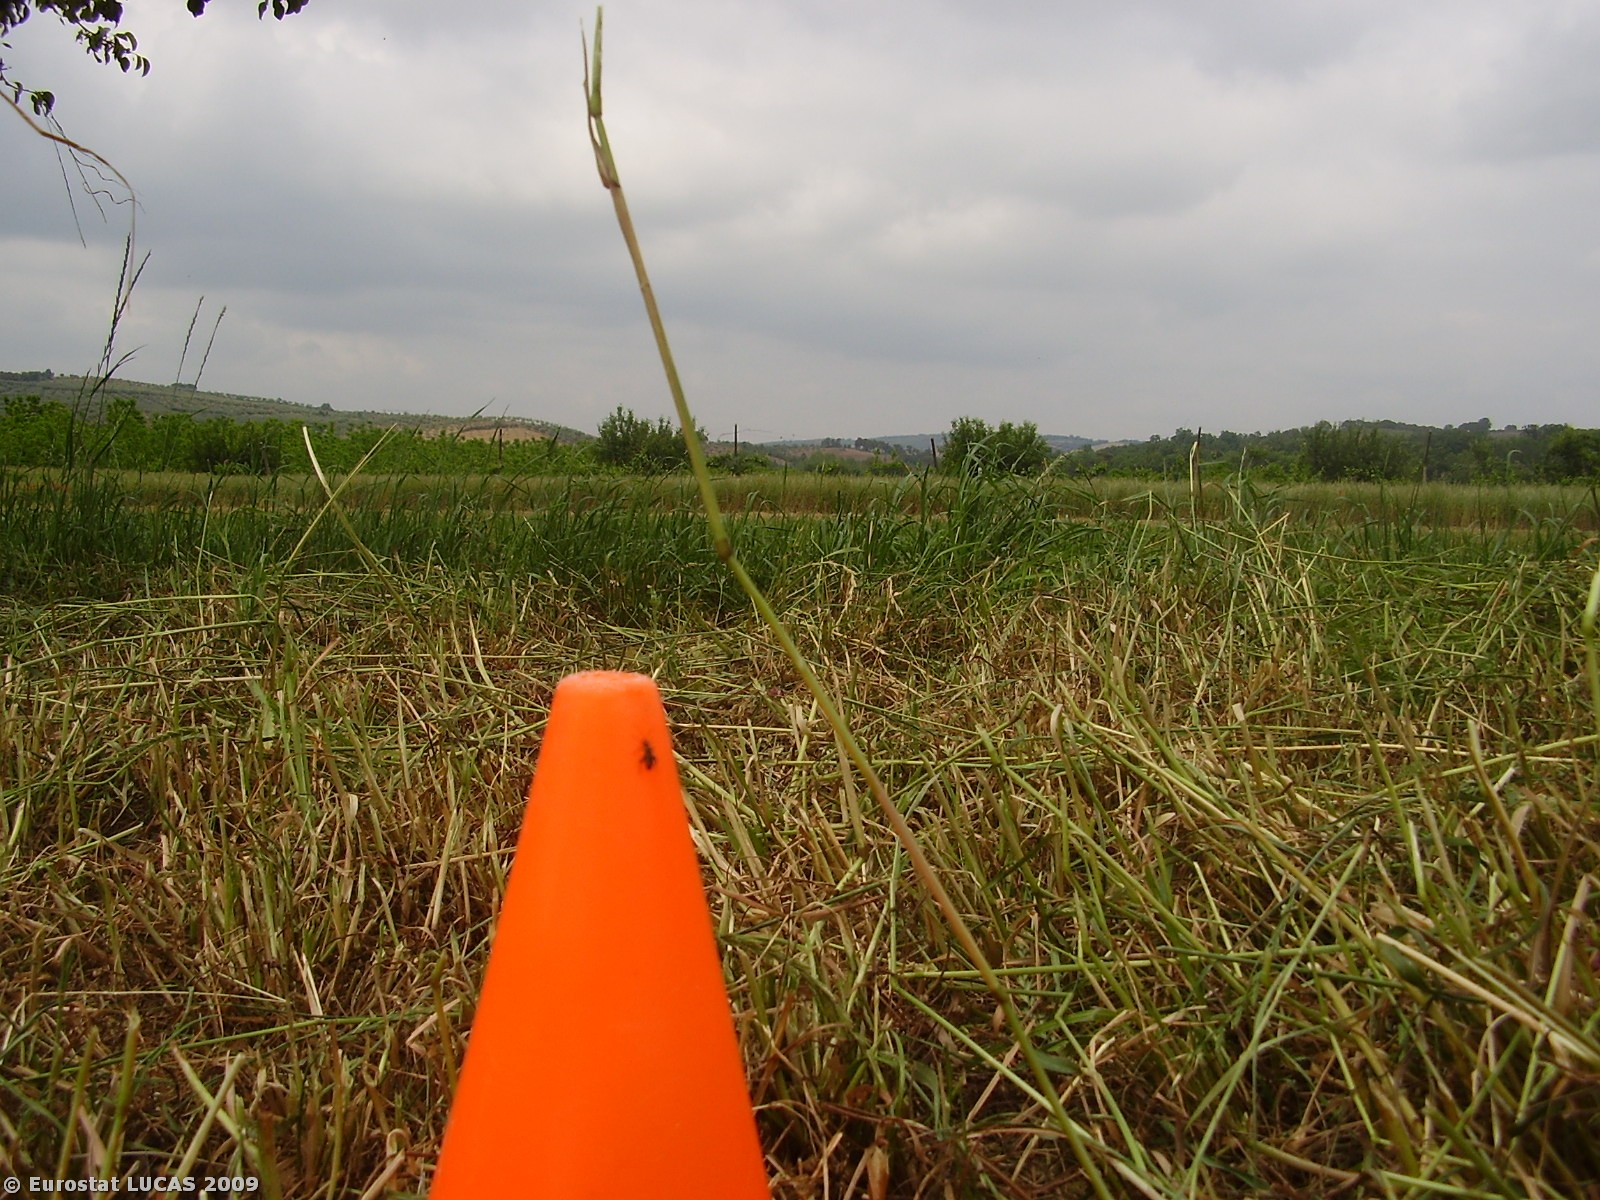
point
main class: Cropland
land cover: Mixed cereals for fodder
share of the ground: > 75 %
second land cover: Pear fruit
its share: < 10 %
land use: Agriculture (excluding fallow land and kitchen gardens)
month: June
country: PT
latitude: 41.5596
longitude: -6.8628
